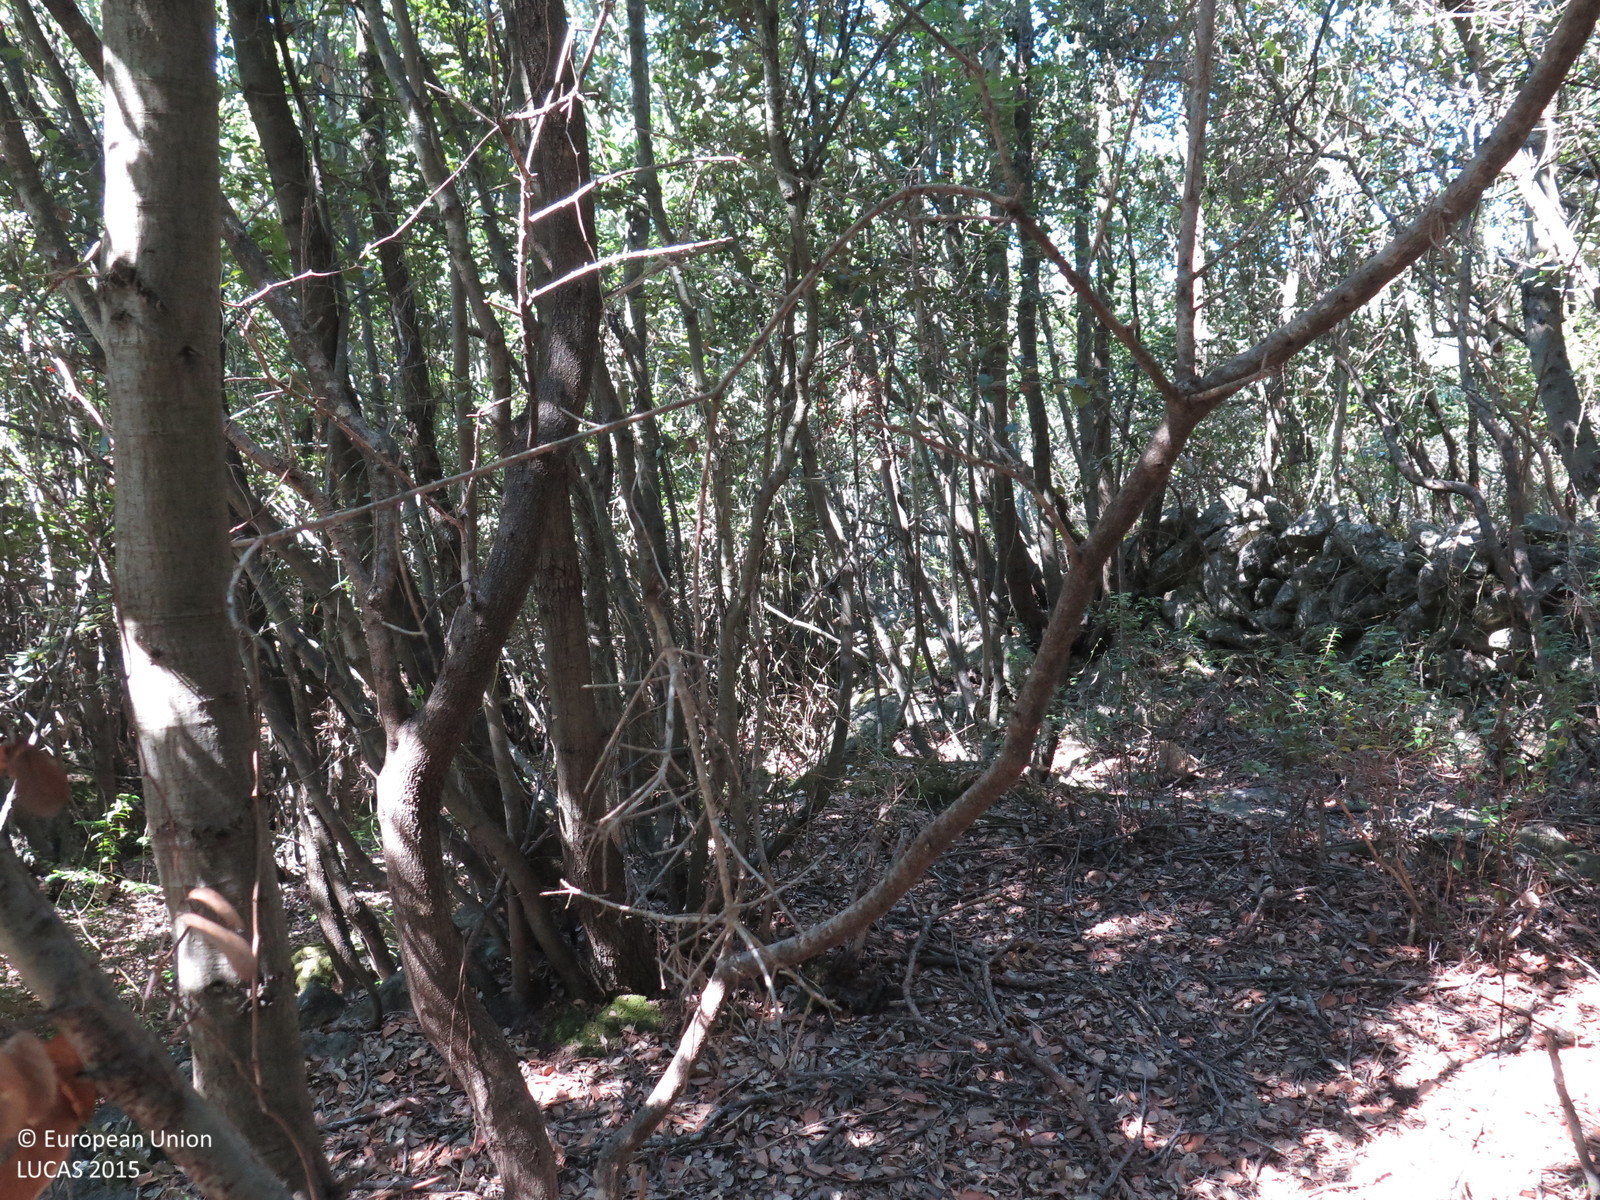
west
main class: Woodland
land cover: Broadleaved woodland
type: thermophilous deciduous forest
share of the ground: > 75 %
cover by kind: broadleaved forest trees 90 %, shrubs 5 %, herbaceous plants 5 %
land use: Semi-natural and natural areas not in use
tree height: < 5 m
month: September
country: HR
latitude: 44.6325
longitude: 14.4935
